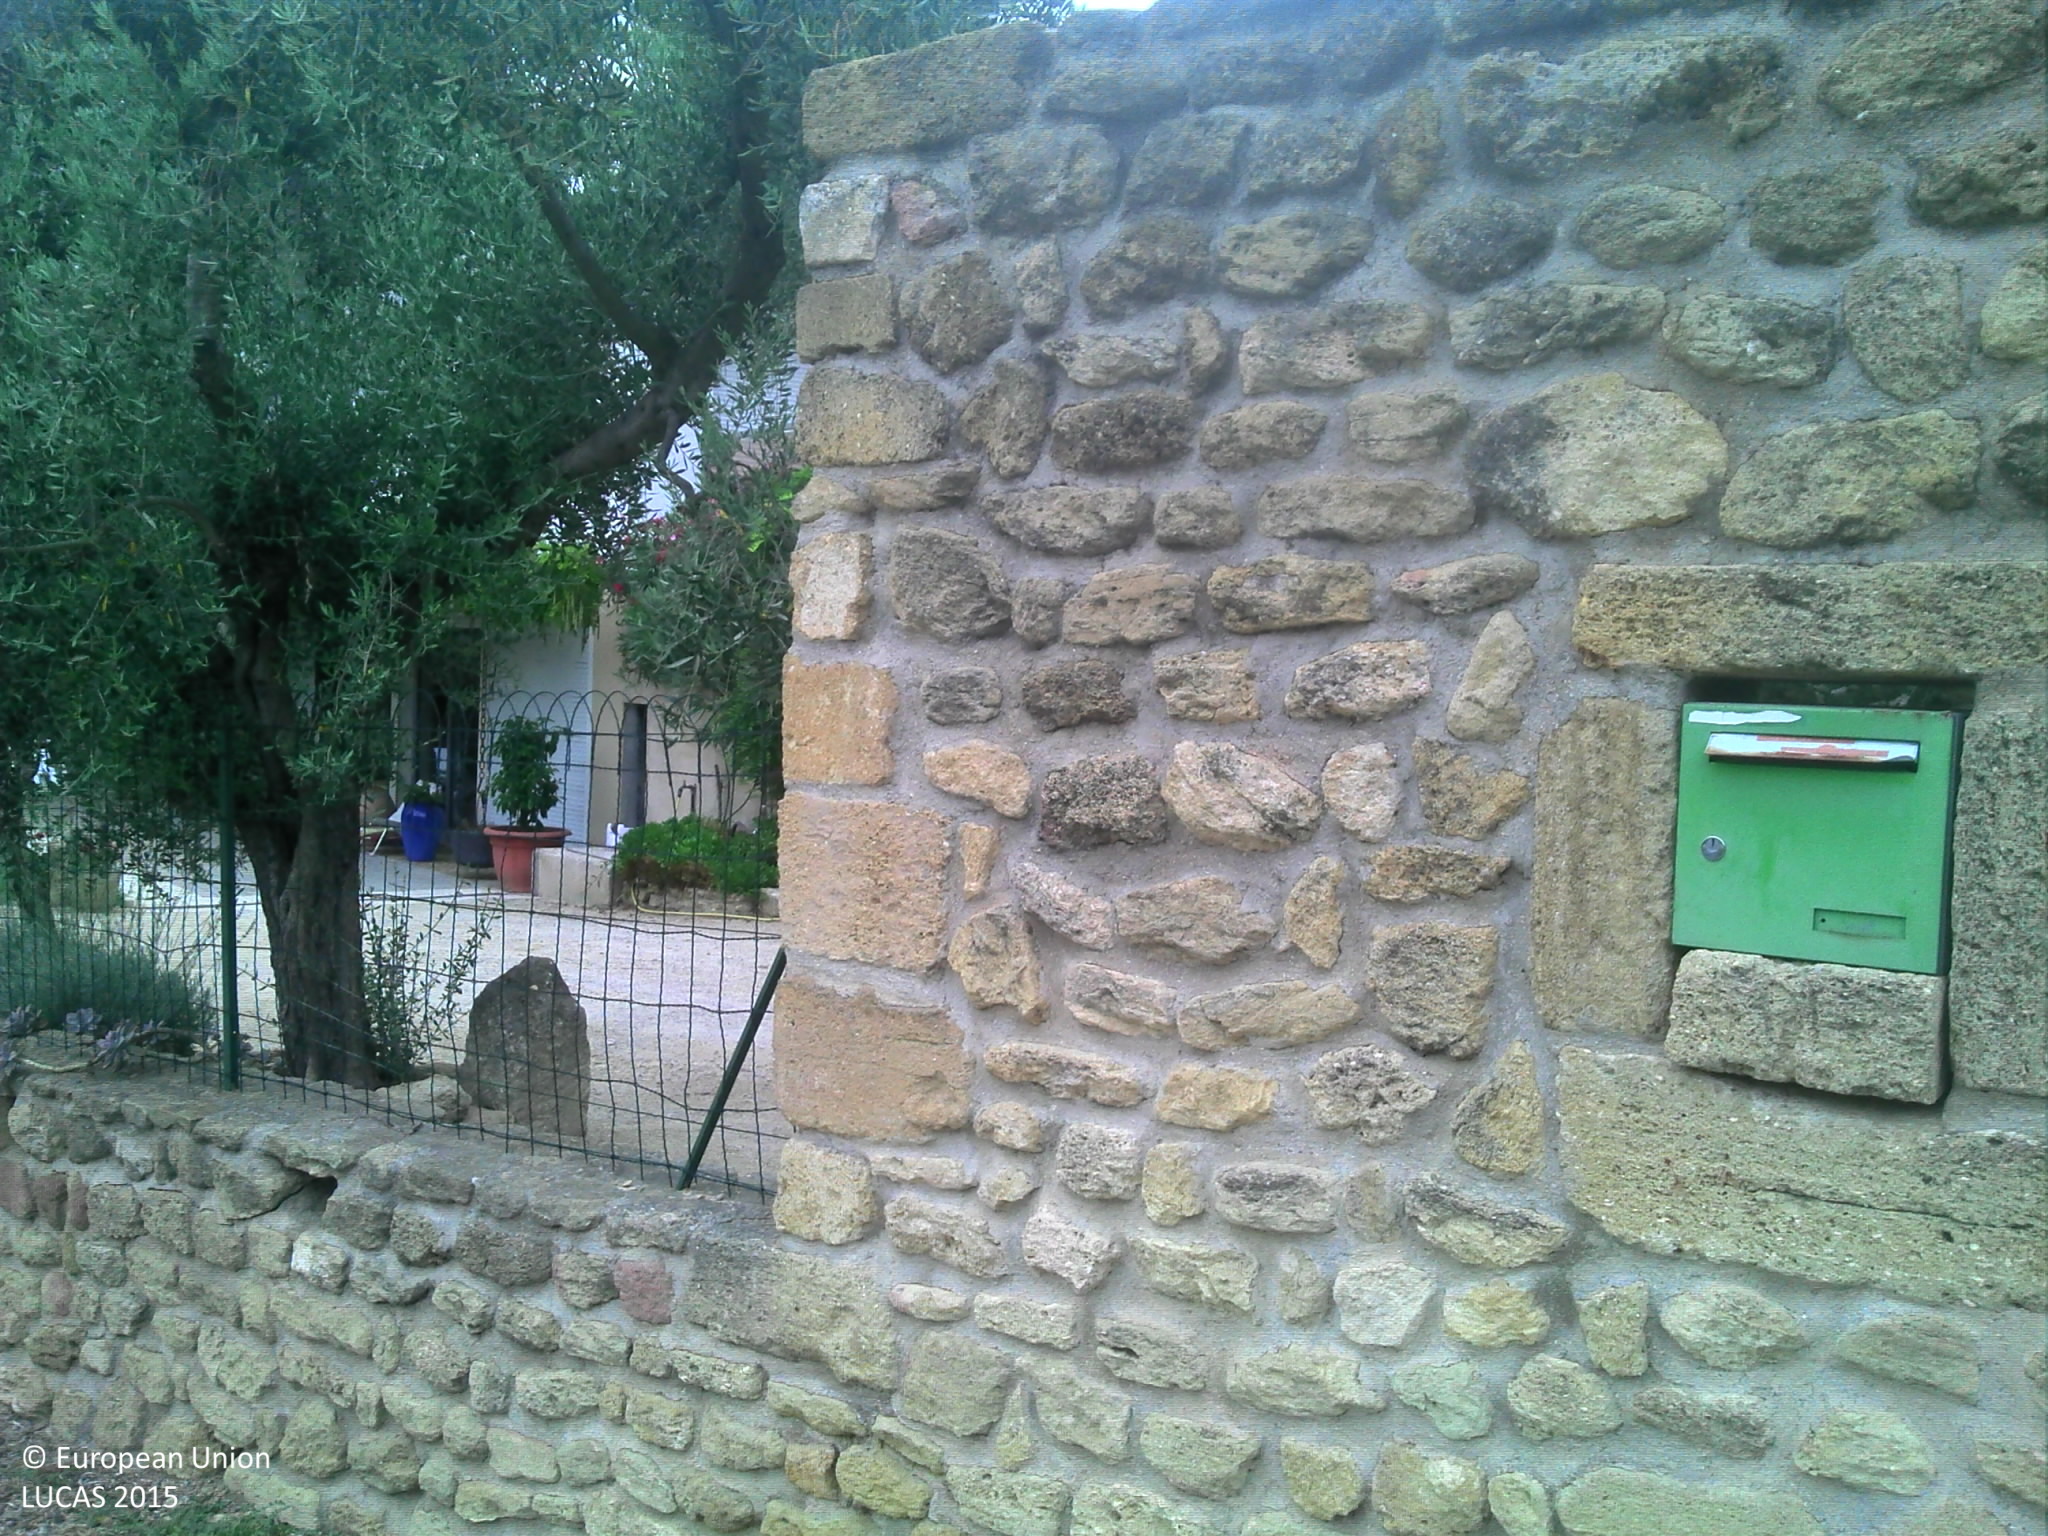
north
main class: Woodland
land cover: Other coniferous woodland
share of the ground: > 75 %
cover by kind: coniferous forest trees 30 %, herbaceous plants 25 %, consolidated bare surface 10 %
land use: Residential
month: July
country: FR
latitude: 43.5647
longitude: 5.0698
